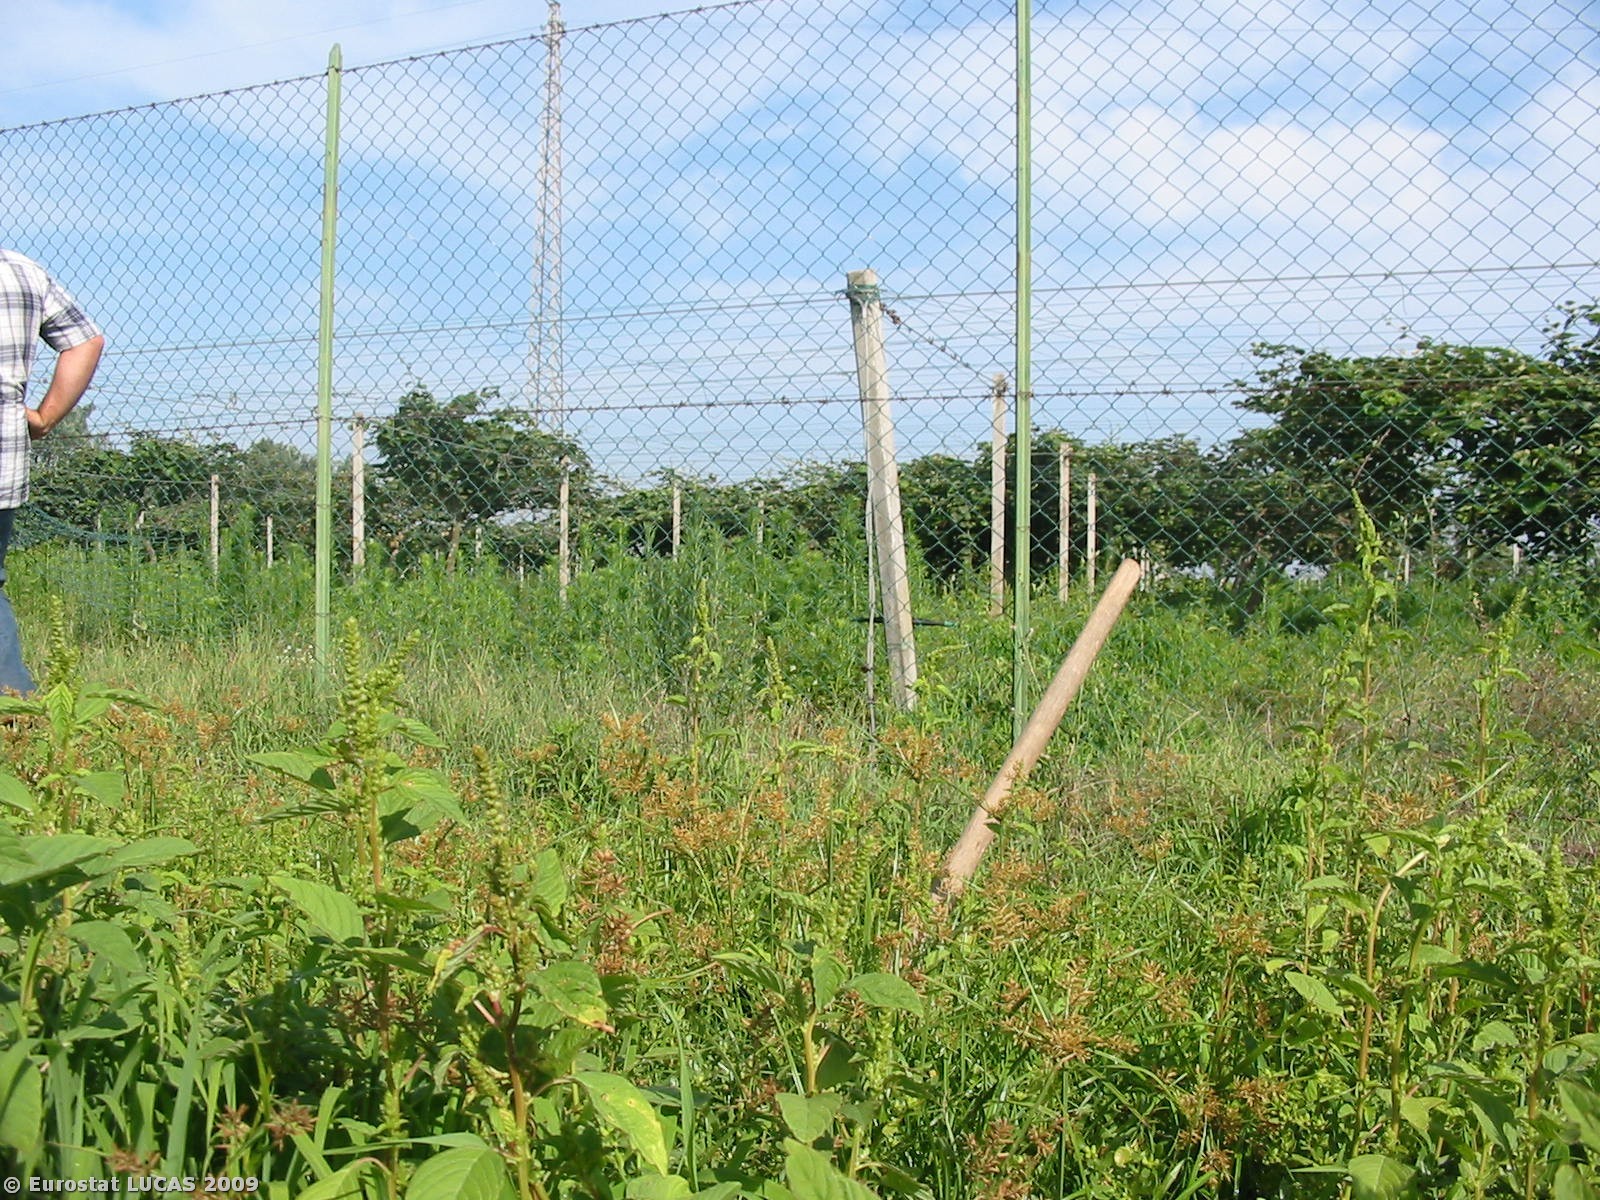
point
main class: Cropland
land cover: Other citrus fruit
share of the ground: 50 - 75 %
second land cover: Spontaneously vegetated surfaces
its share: > 75 %
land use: Agriculture (excluding fallow land and kitchen gardens)
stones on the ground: < 10 %
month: July
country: IT
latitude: 38.4517
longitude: 15.9580
